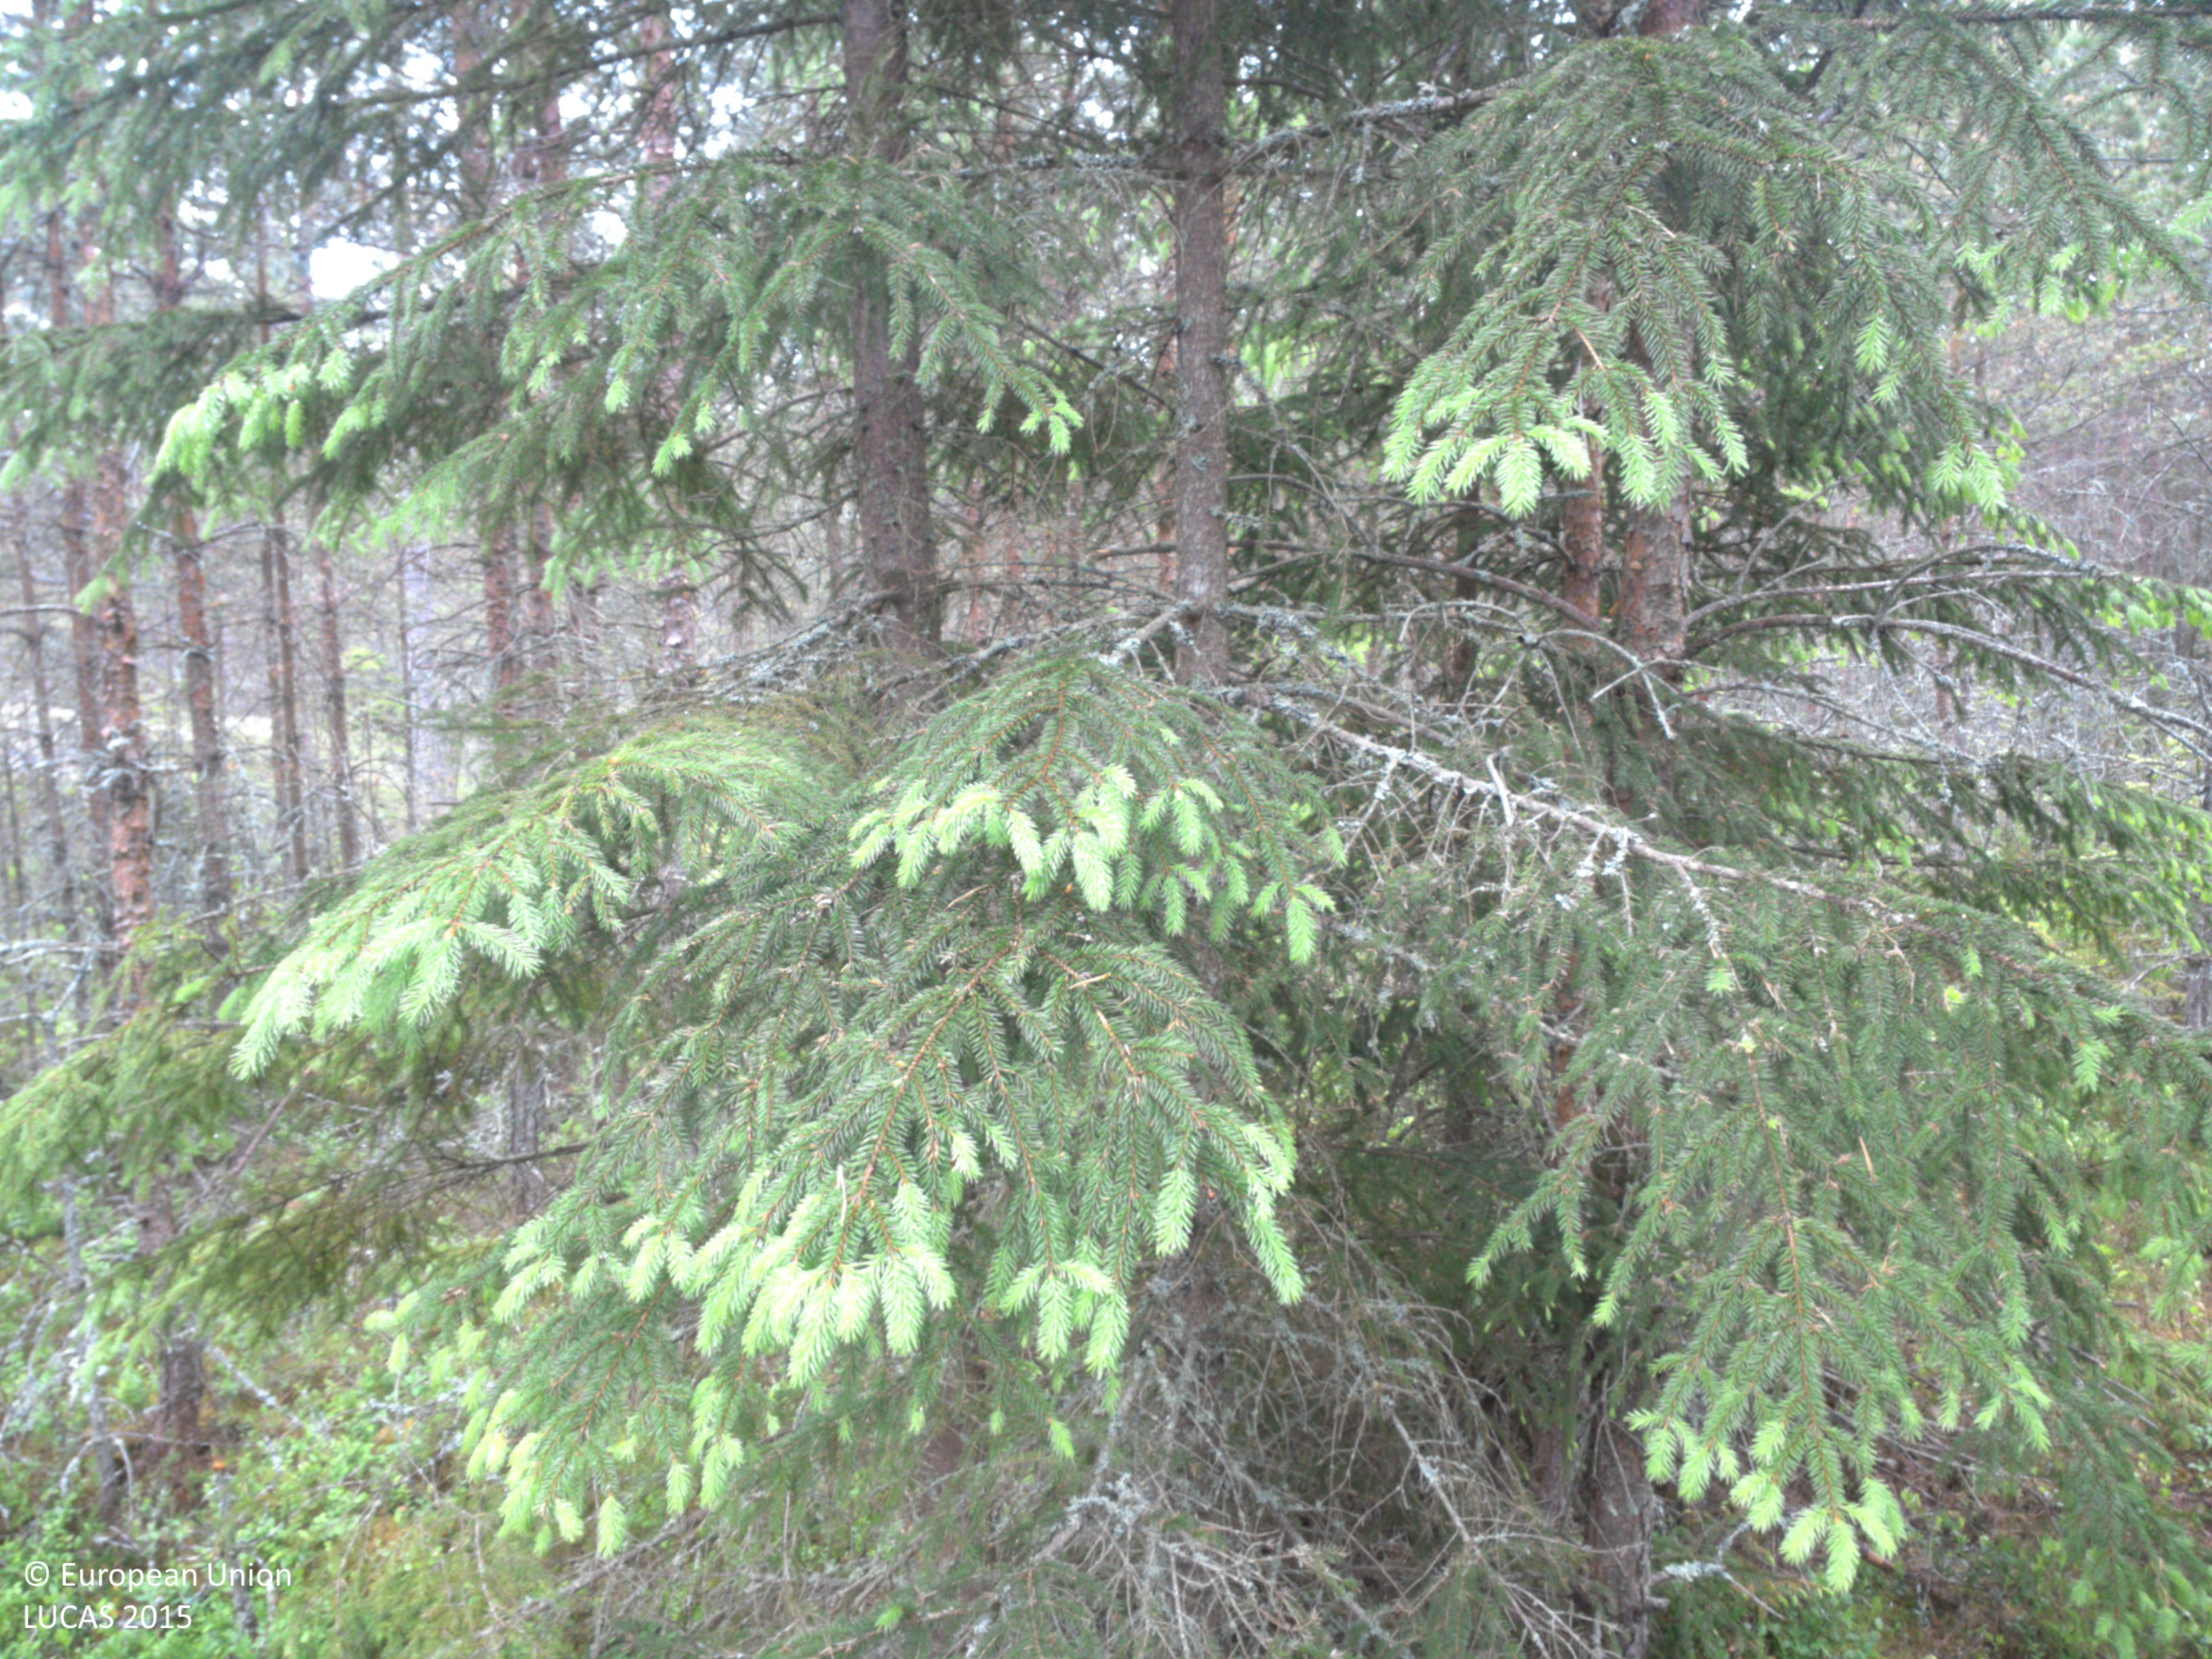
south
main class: Woodland
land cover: Pine dominated coniferous woodland
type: boreal forest
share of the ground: 50 - 75 %
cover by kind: coniferous forest trees 50 %, lichens and mosses 30 %, shrubs 20 %
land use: Forestry
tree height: > 5 m
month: June
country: SE
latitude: 59.1038
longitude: 12.0379
